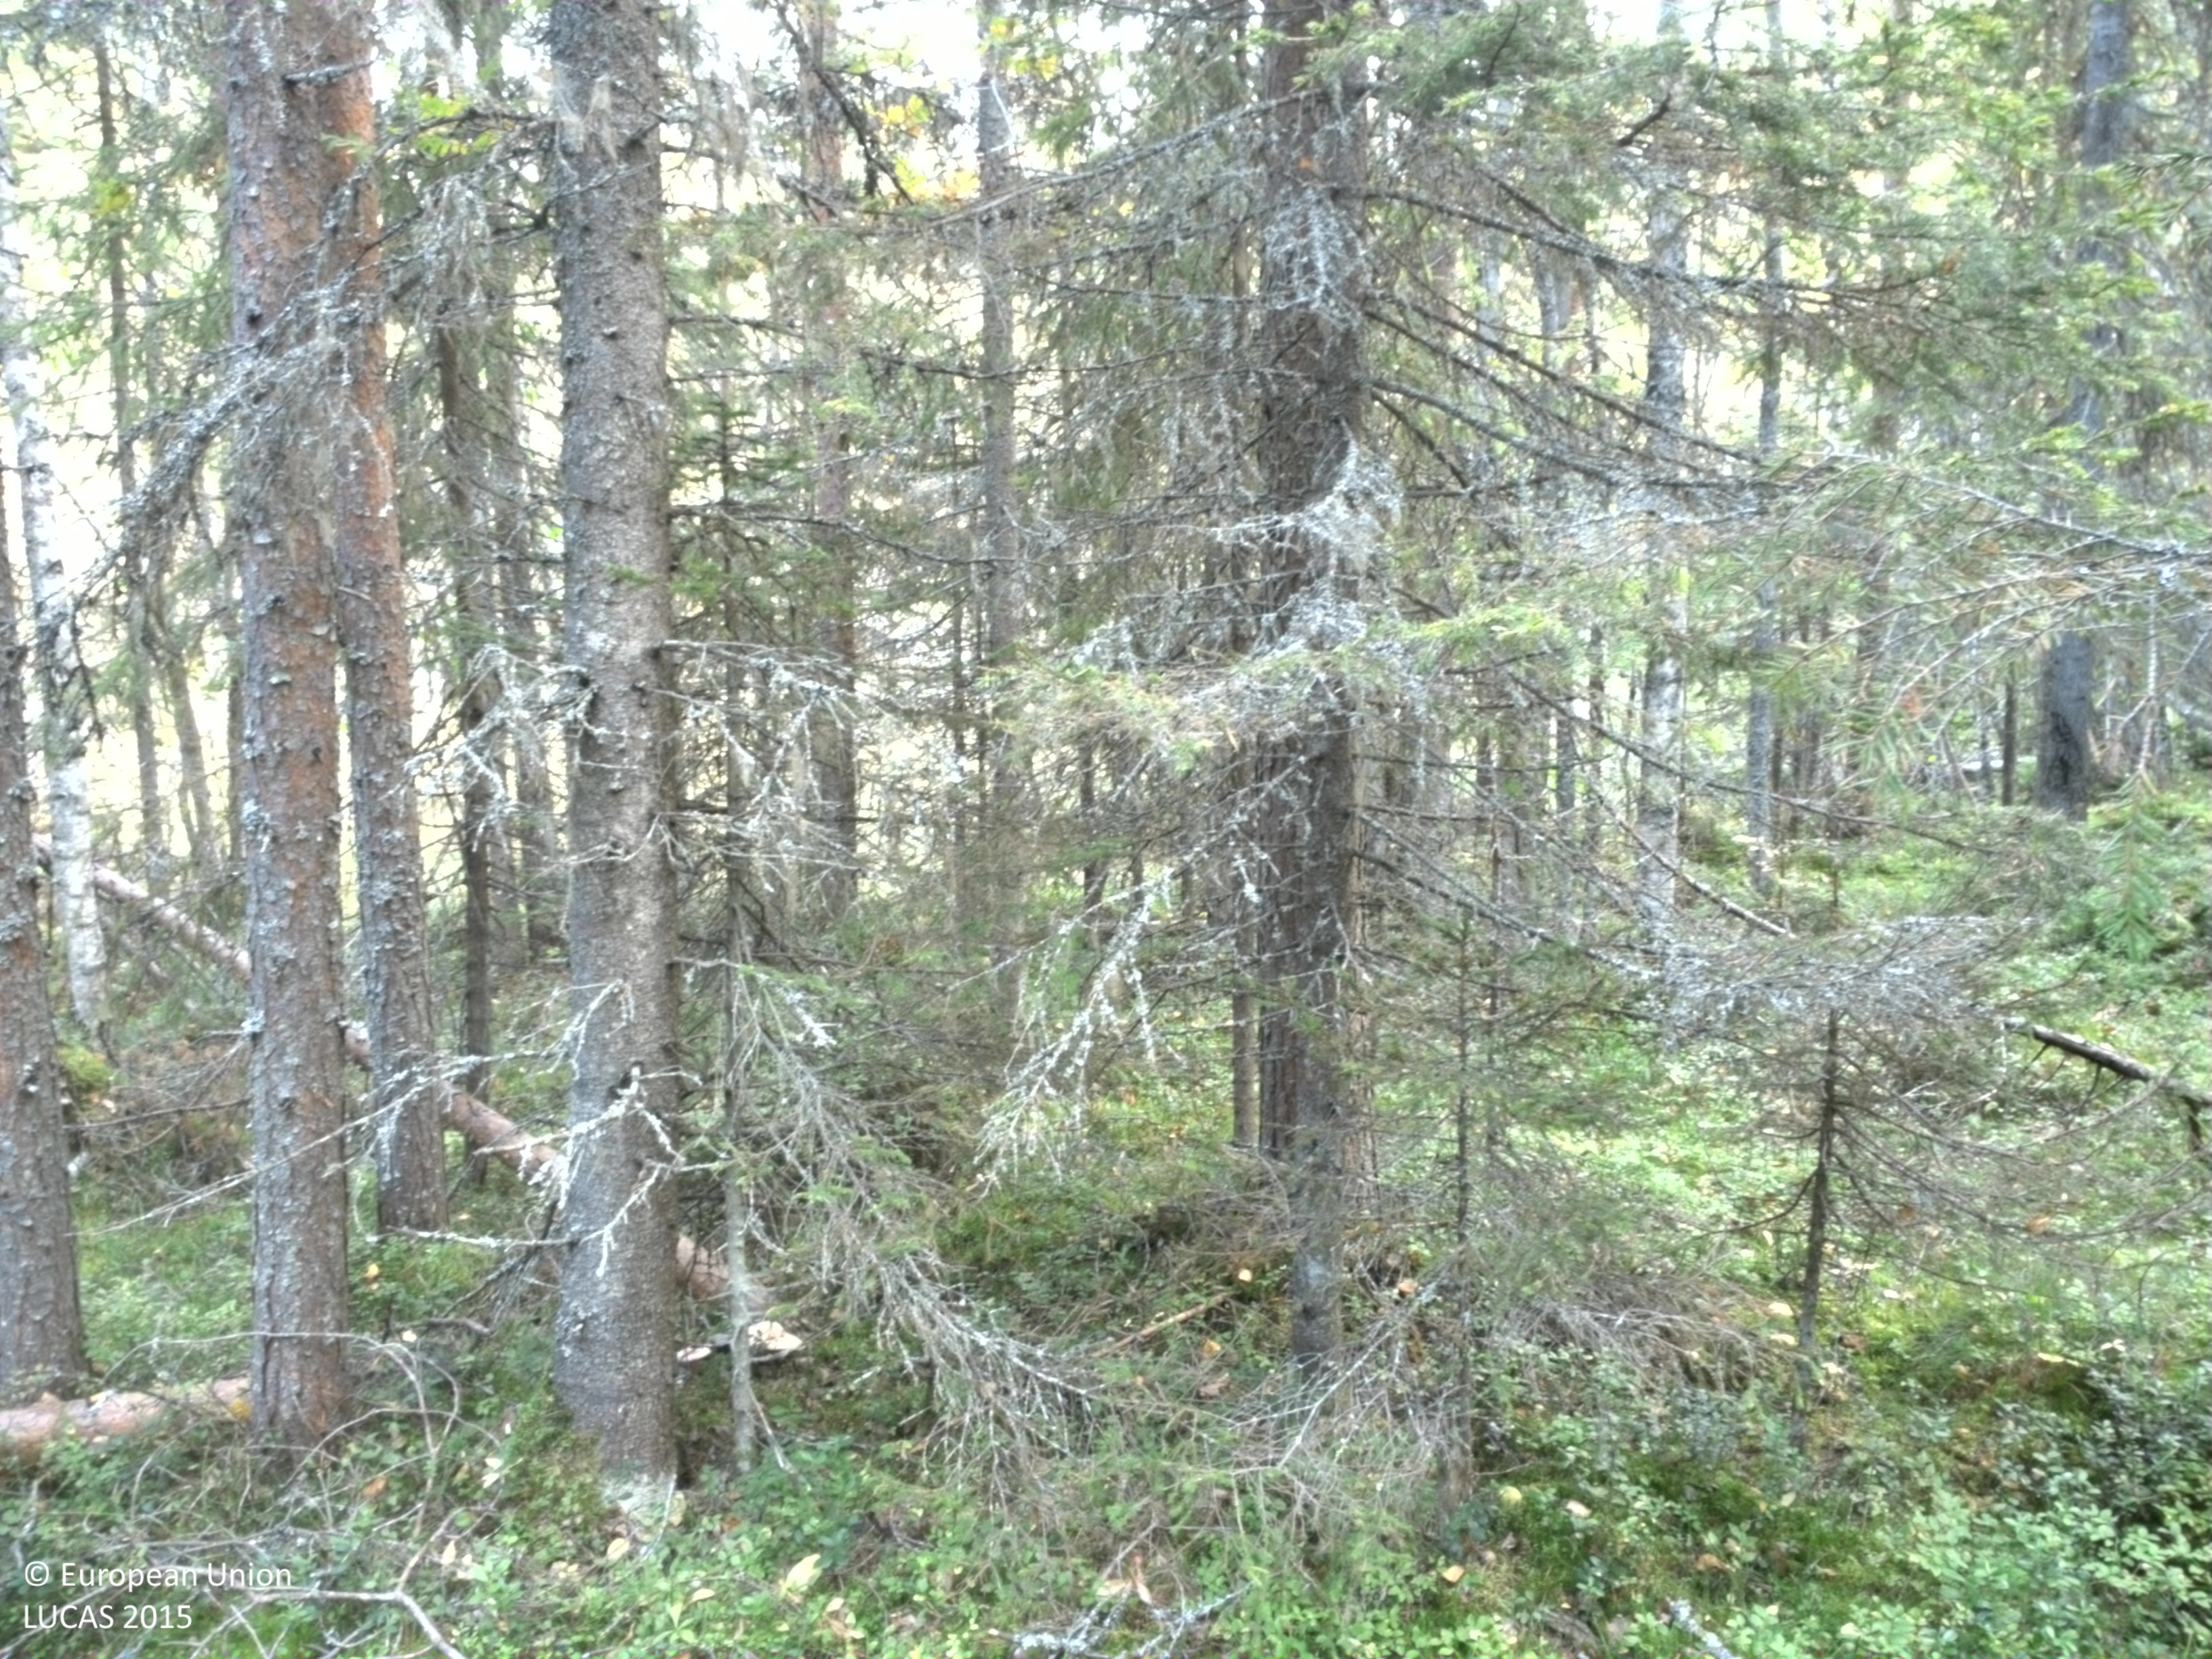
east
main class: Woodland
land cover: Spruce dominated coniferous woodland
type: boreal forest
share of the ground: 25 - 50 %
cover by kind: shrubs 50 %, coniferous forest trees 40 %, lichens and mosses 10 %
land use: Forestry
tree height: > 5 m
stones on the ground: < 10 %
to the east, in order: Spruce dominated coniferous woodland; Pine dominated mixed woodland; Broadleaved woodland; Peatbogs; Pine dominated mixed woodland; Ditches and canals; Groves; Tracks; Spruce dominated mixed woodland; Broadleaved woodland; Grassland with sparse tree/shrub cover; Broadleaved woodland
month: September
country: SE
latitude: 65.5097
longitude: 21.8464
